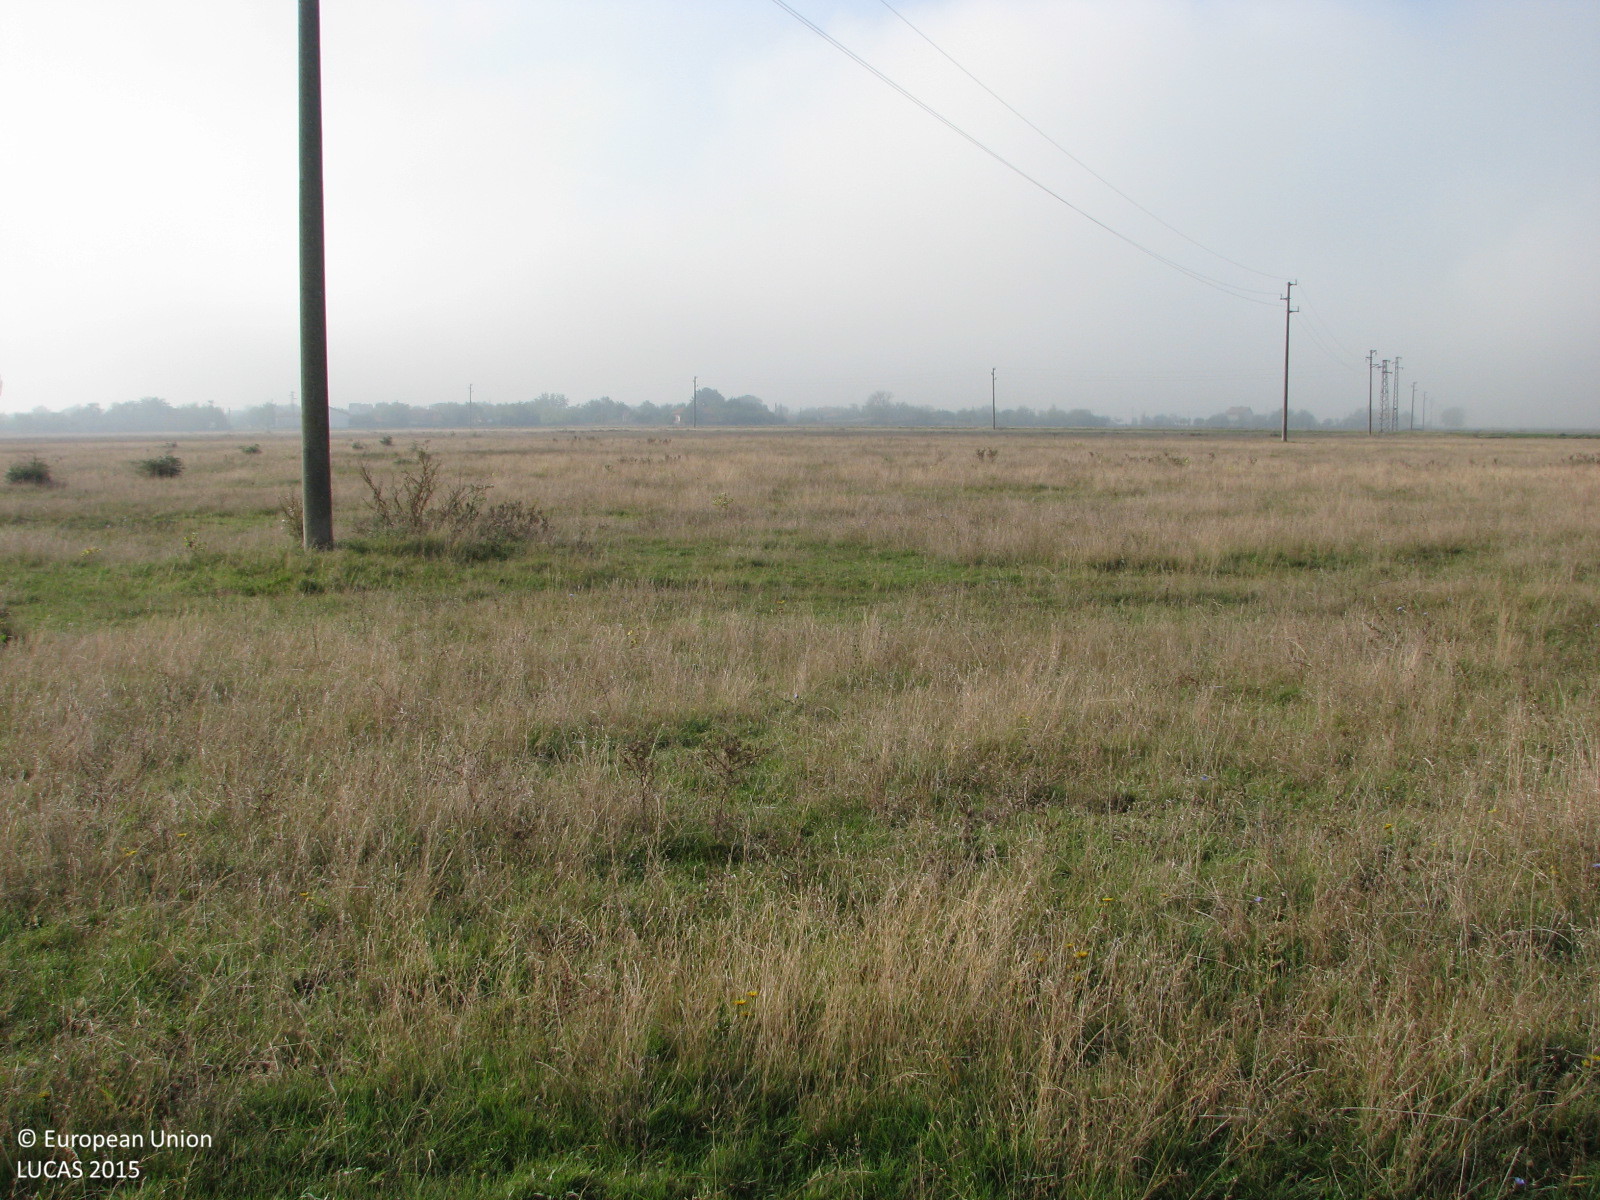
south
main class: Grassland
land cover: Grassland without tree/shrub cover
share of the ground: > 75 %
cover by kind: herbaceous plants 100 %
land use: Agriculture (excluding fallow land and kitchen gardens)
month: October
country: BG
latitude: 42.4192
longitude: 25.8883
